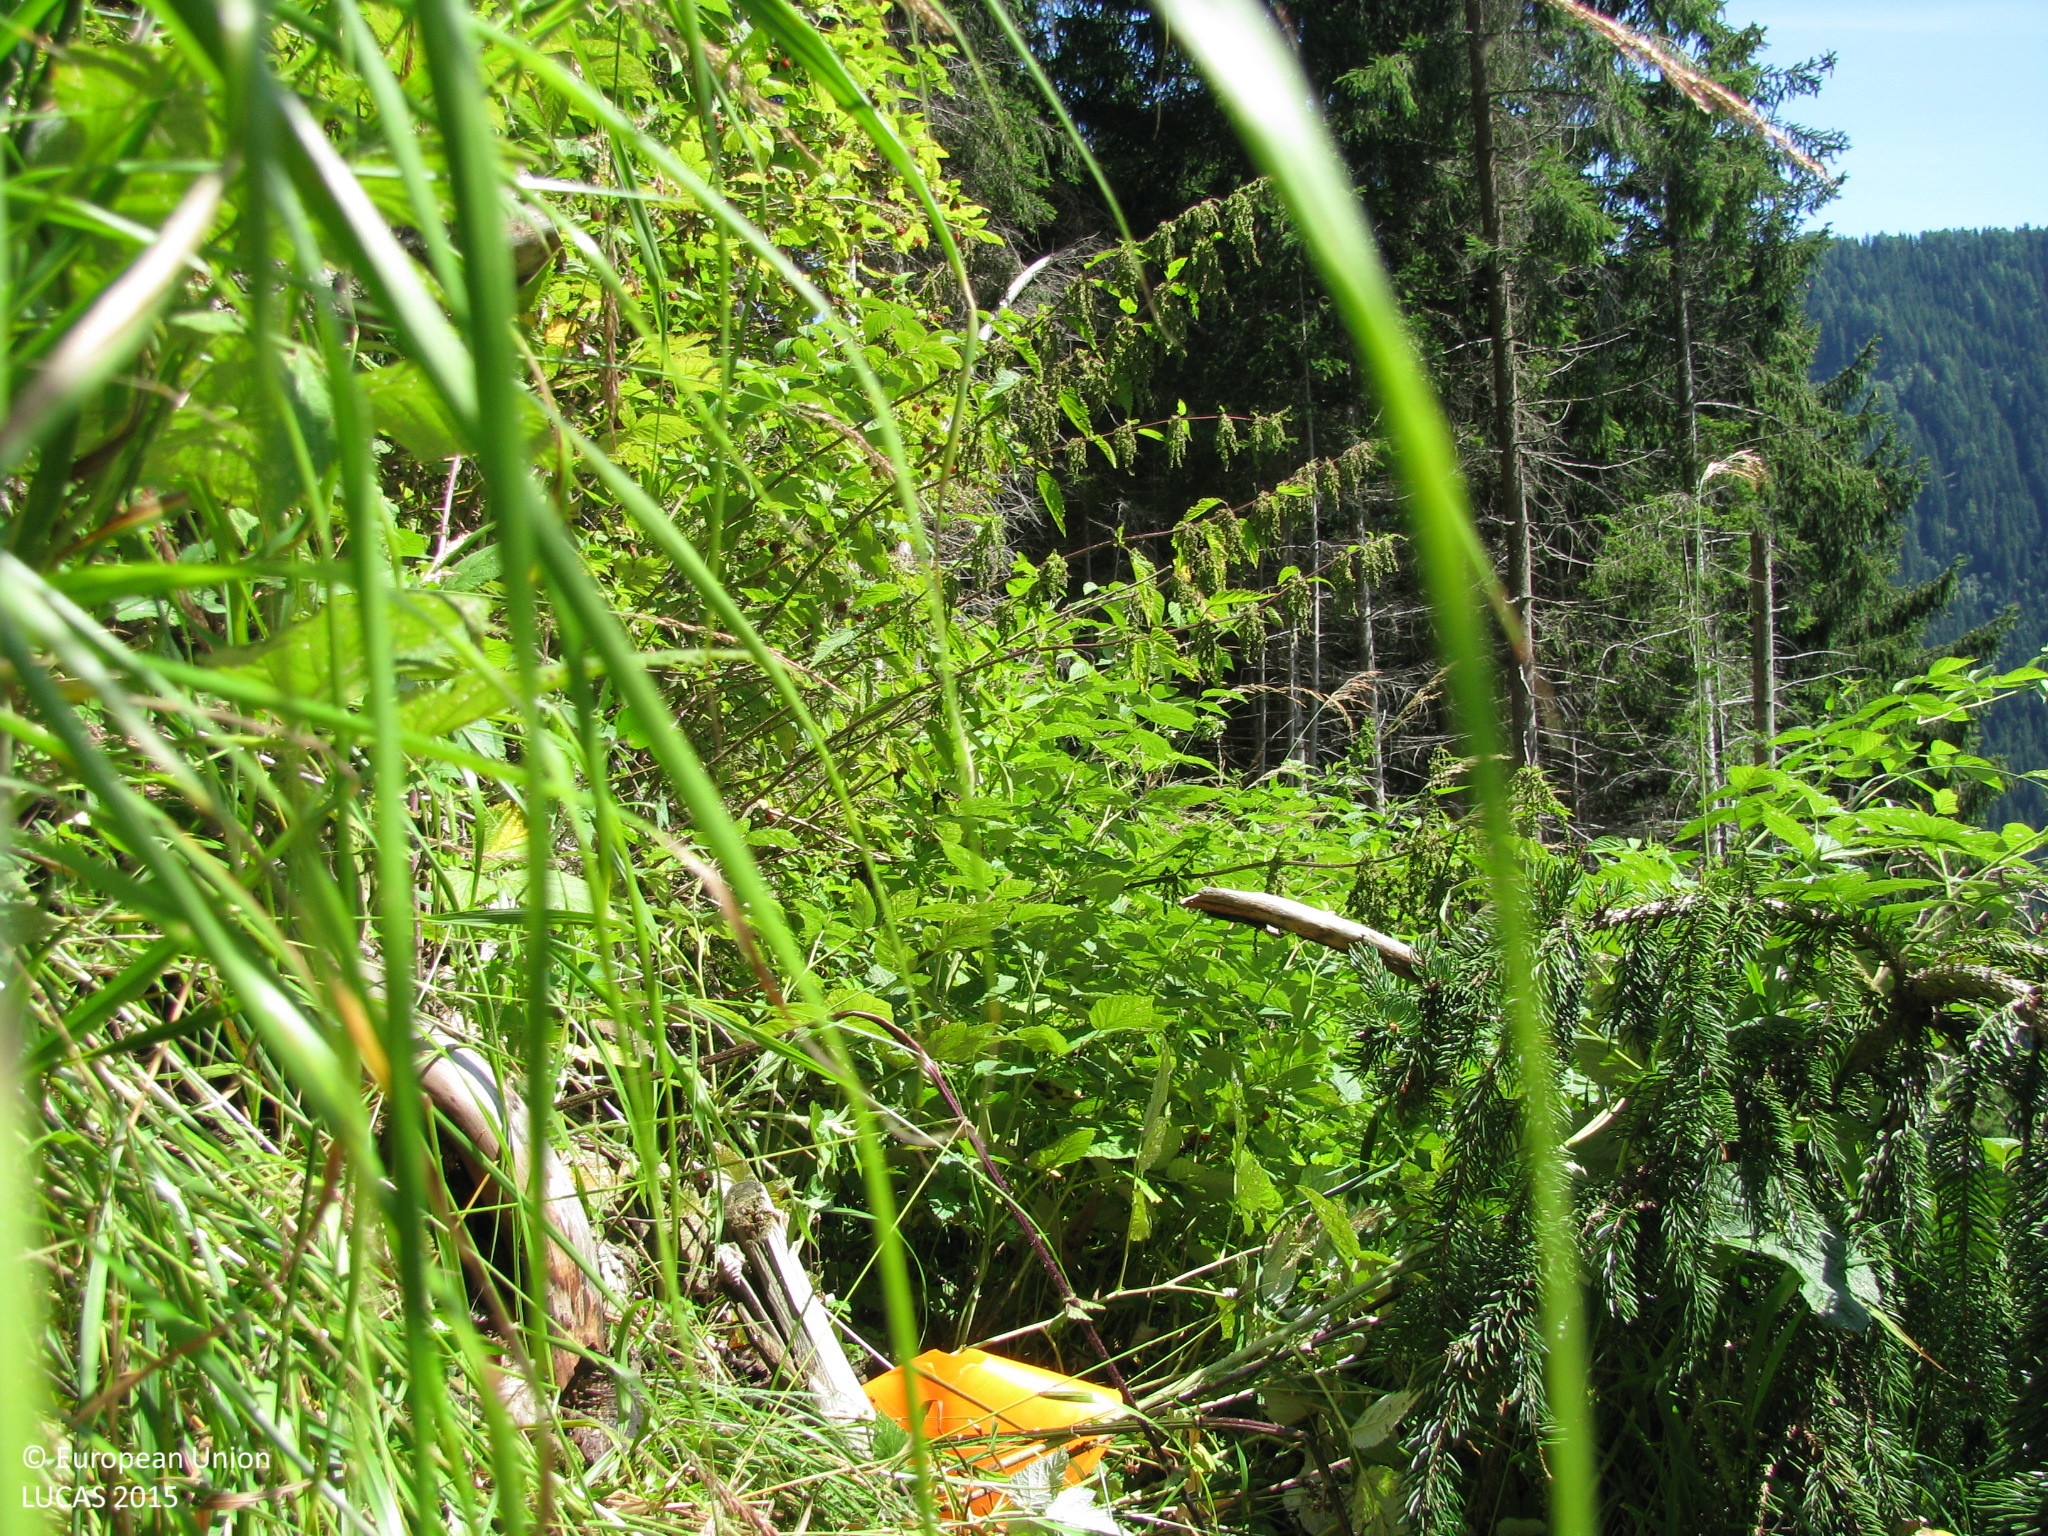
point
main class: Shrubland
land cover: Shrubland with sparse tree cover
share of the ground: > 75 %
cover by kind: shrubs 70 %, herbaceous plants 25 %, coniferous forest trees 5 %
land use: Forestry
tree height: < 5 m
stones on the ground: 25 - 50 %
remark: Clear cut
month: July
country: AT
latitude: 46.8547
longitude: 12.8174
